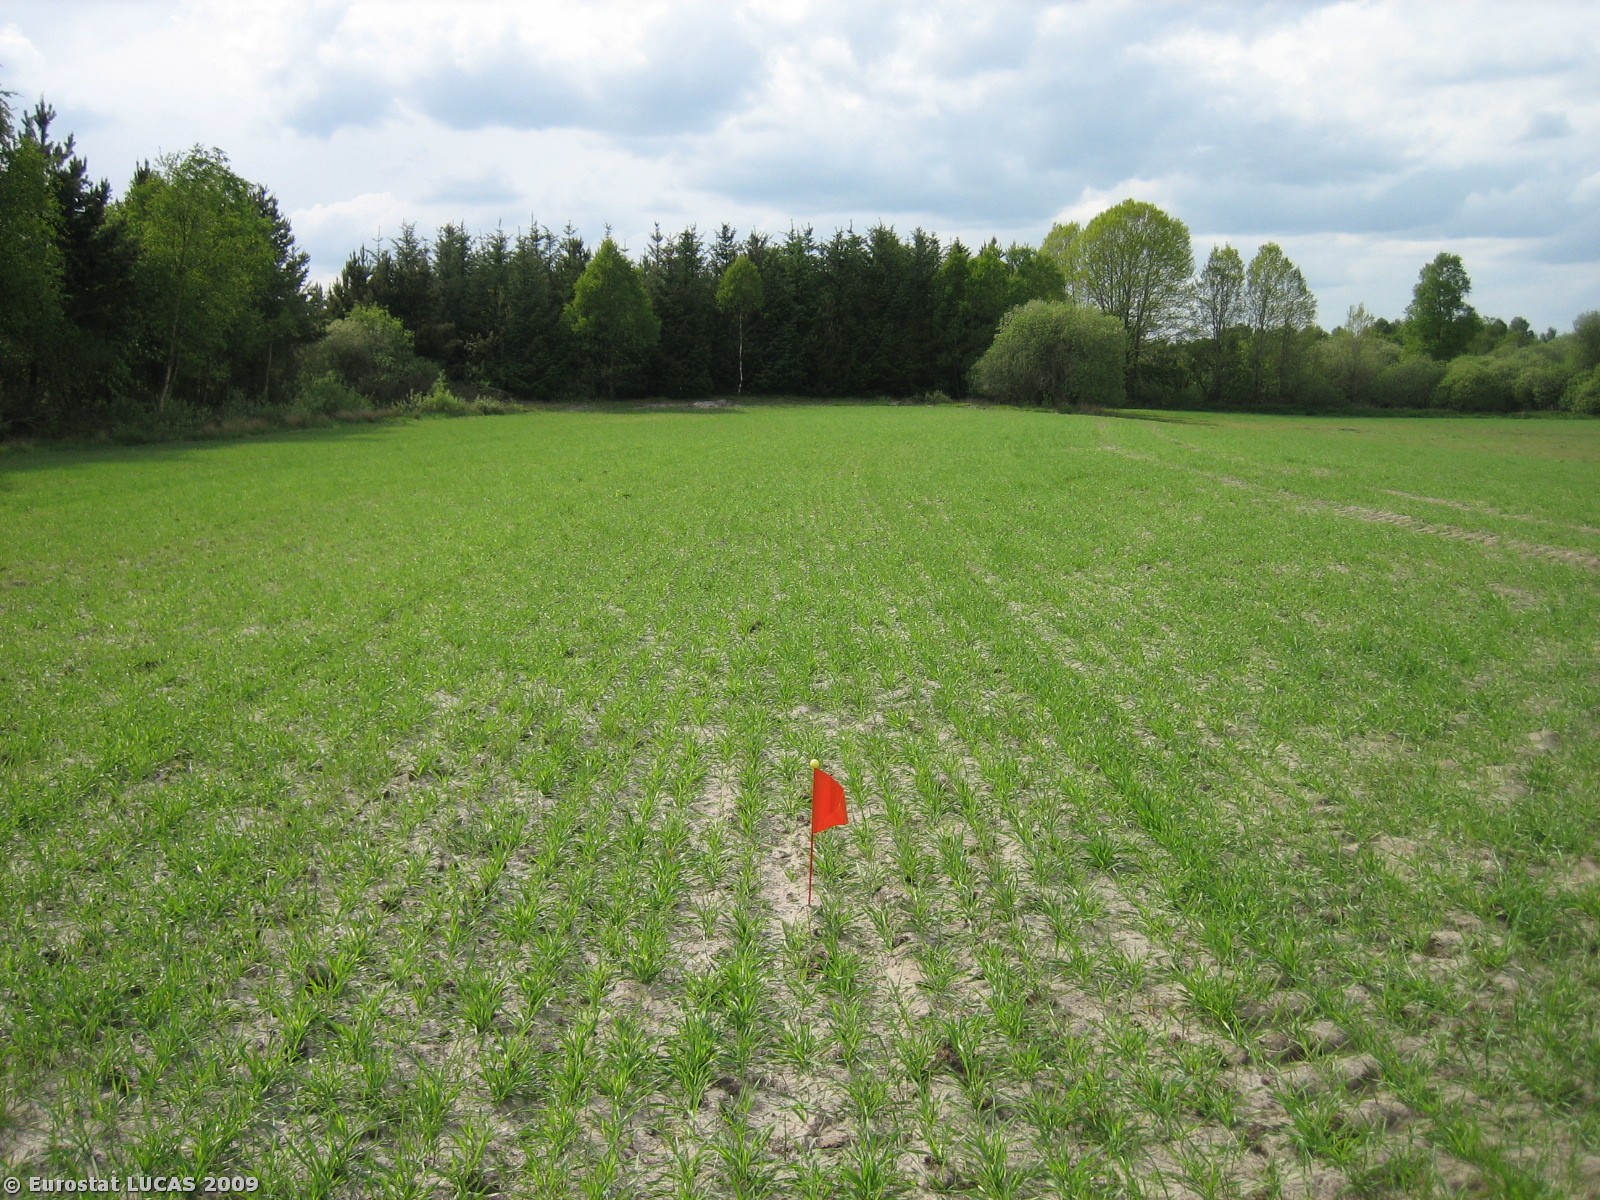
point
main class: Cropland
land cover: Barley
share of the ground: 25 - 50 %
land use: Agriculture (excluding fallow land and kitchen gardens)
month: May
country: DK
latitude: 56.2213
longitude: 9.2107
